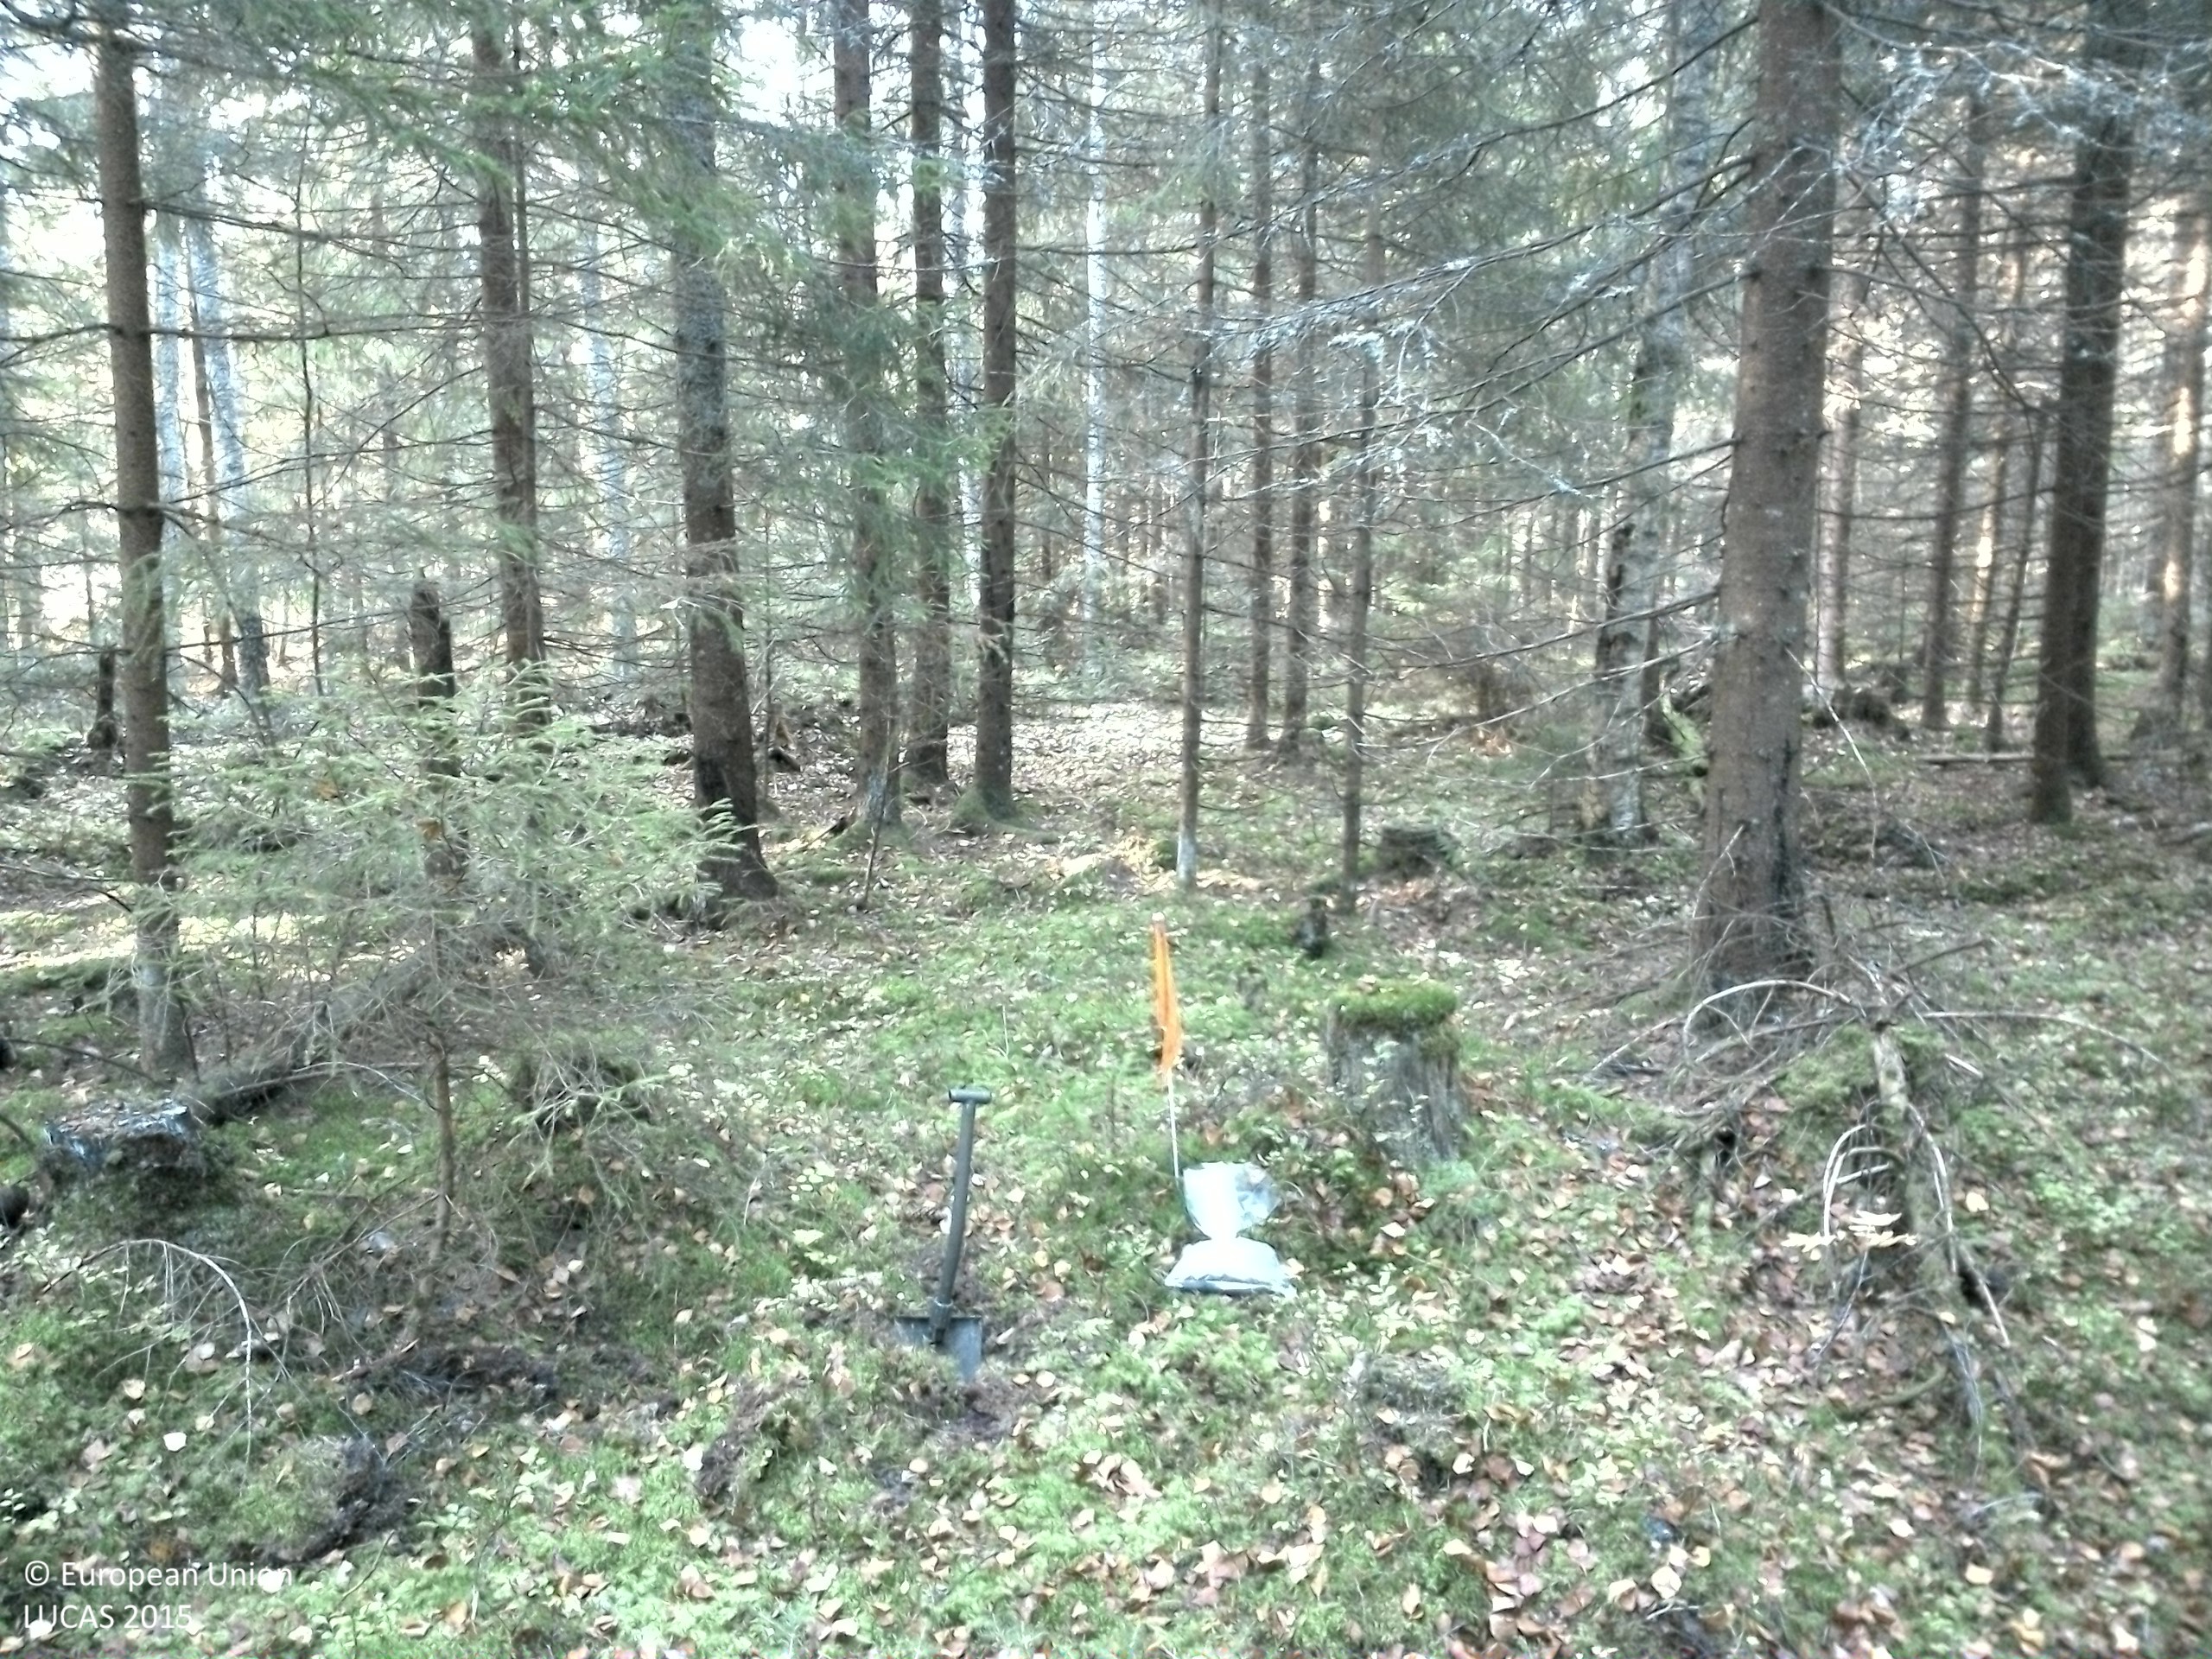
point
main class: Woodland
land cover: Spruce dominated coniferous woodland
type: boreal forest
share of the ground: > 75 %
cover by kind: coniferous forest trees 75 %, shrubs 10 %, lichens and mosses 10 %, broadleaved forest trees 5 %
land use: Forestry
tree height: > 5 m
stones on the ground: < 10 %
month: October
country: SE
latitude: 59.7961
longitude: 16.4959
